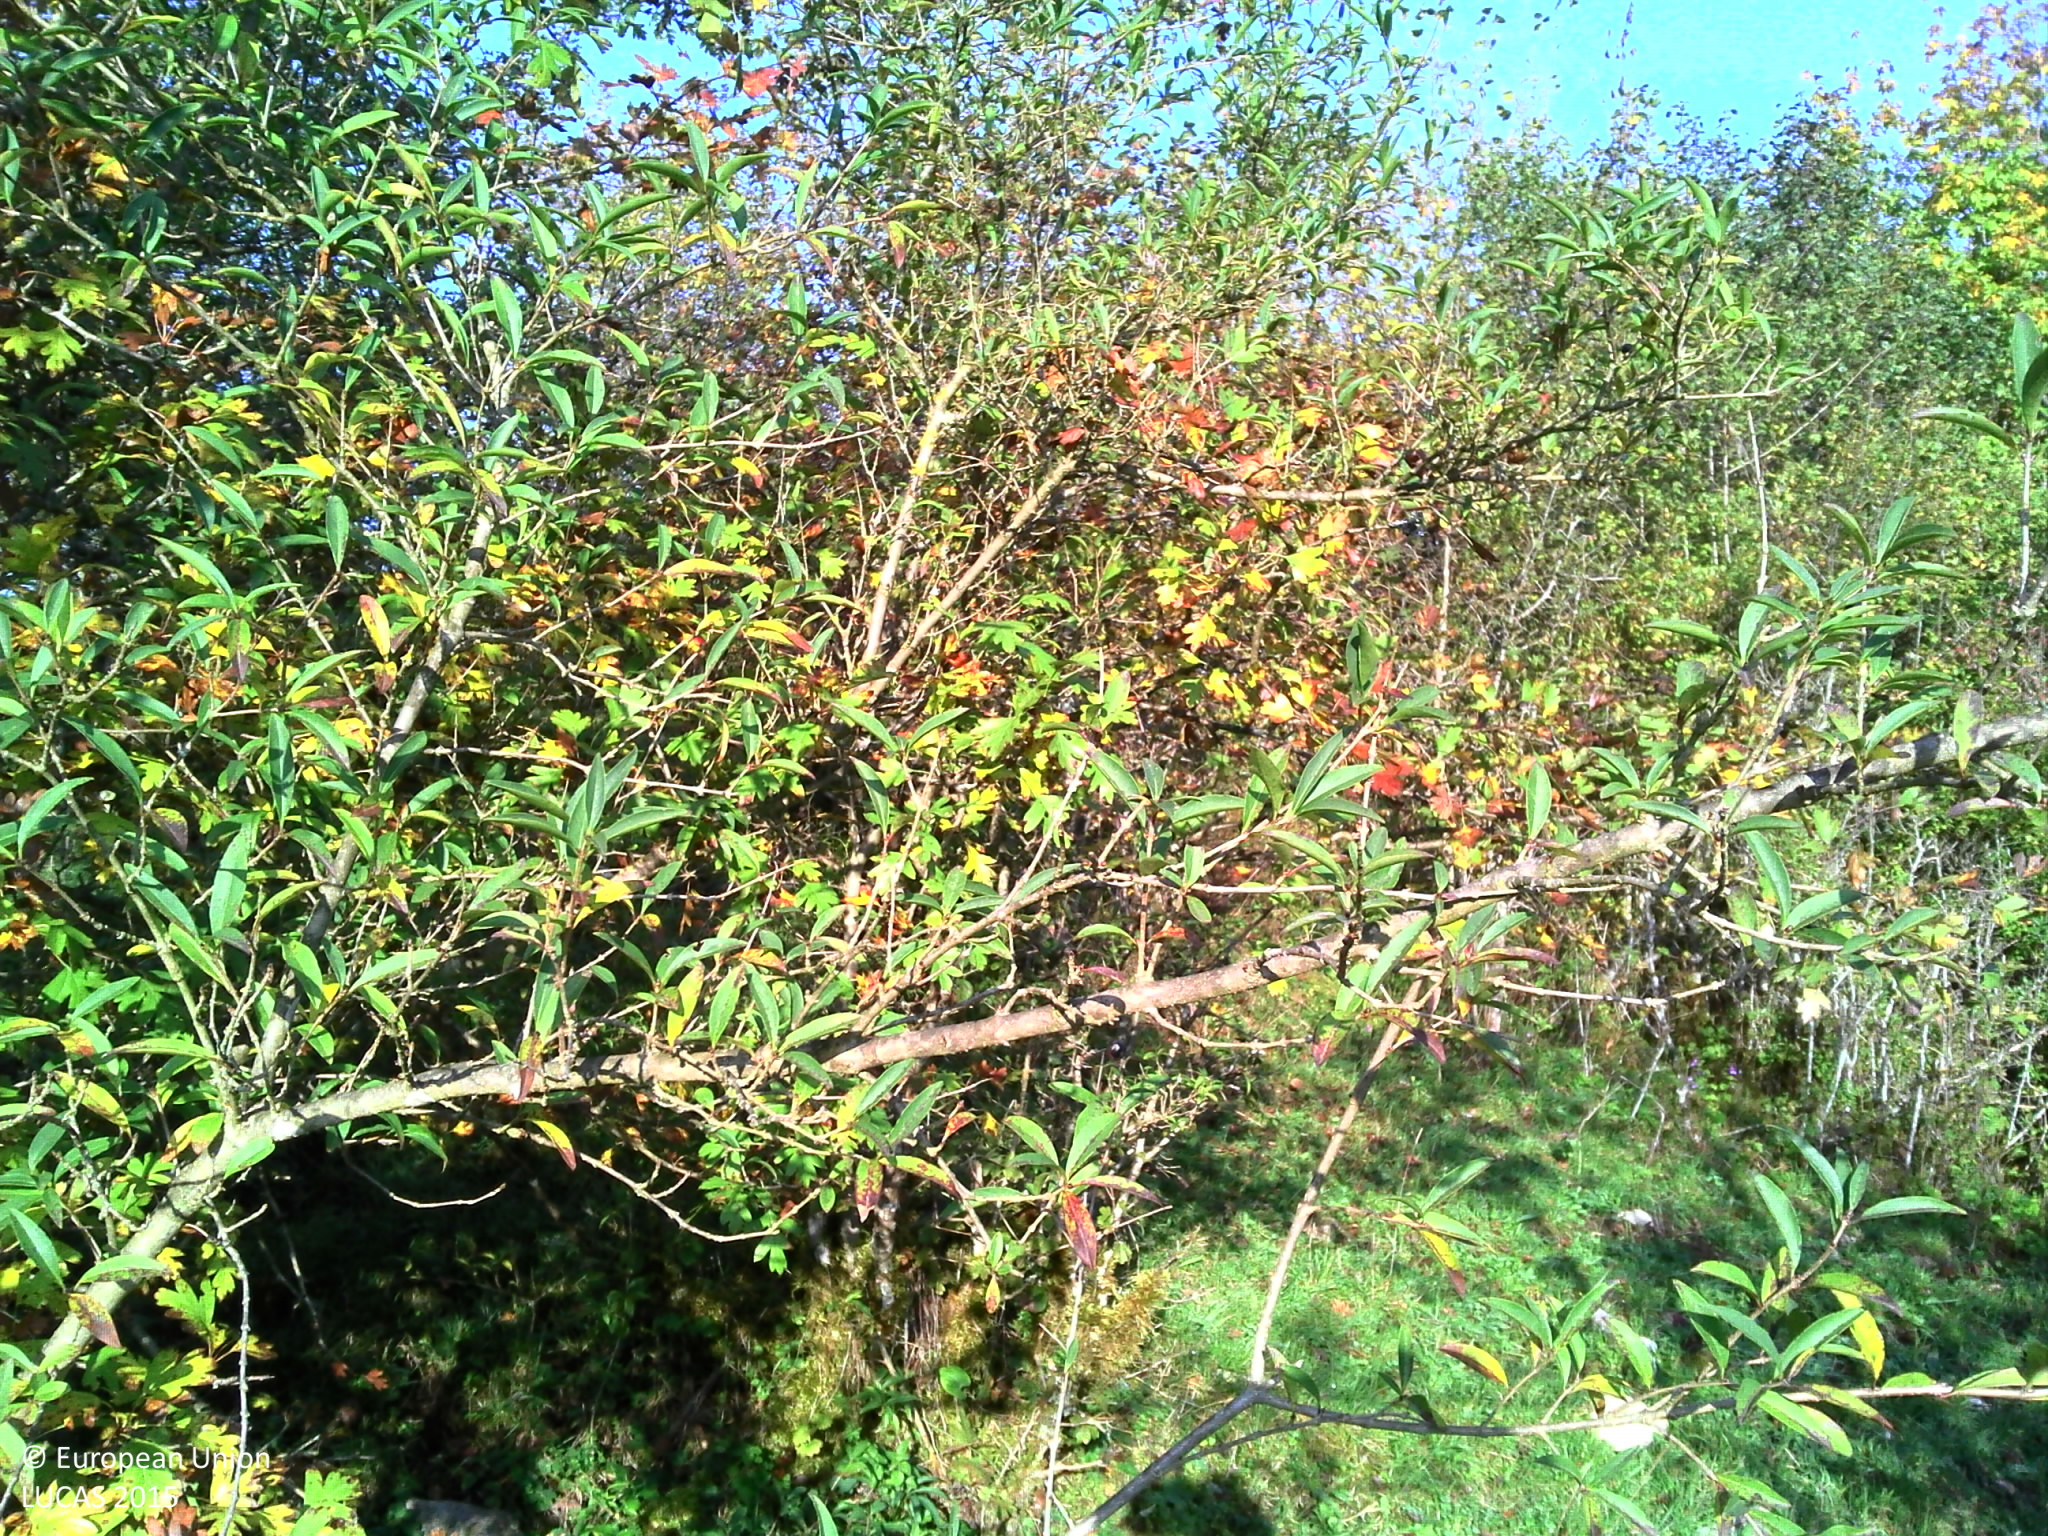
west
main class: Shrubland
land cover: Shrubland with sparse tree cover
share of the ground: > 75 %
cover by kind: shrubs 50 %, herbaceous plants 45 %, broadleaved forest trees 5 %
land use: Semi-natural and natural areas not in use
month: October
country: FR
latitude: 47.1610
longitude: 6.0315
